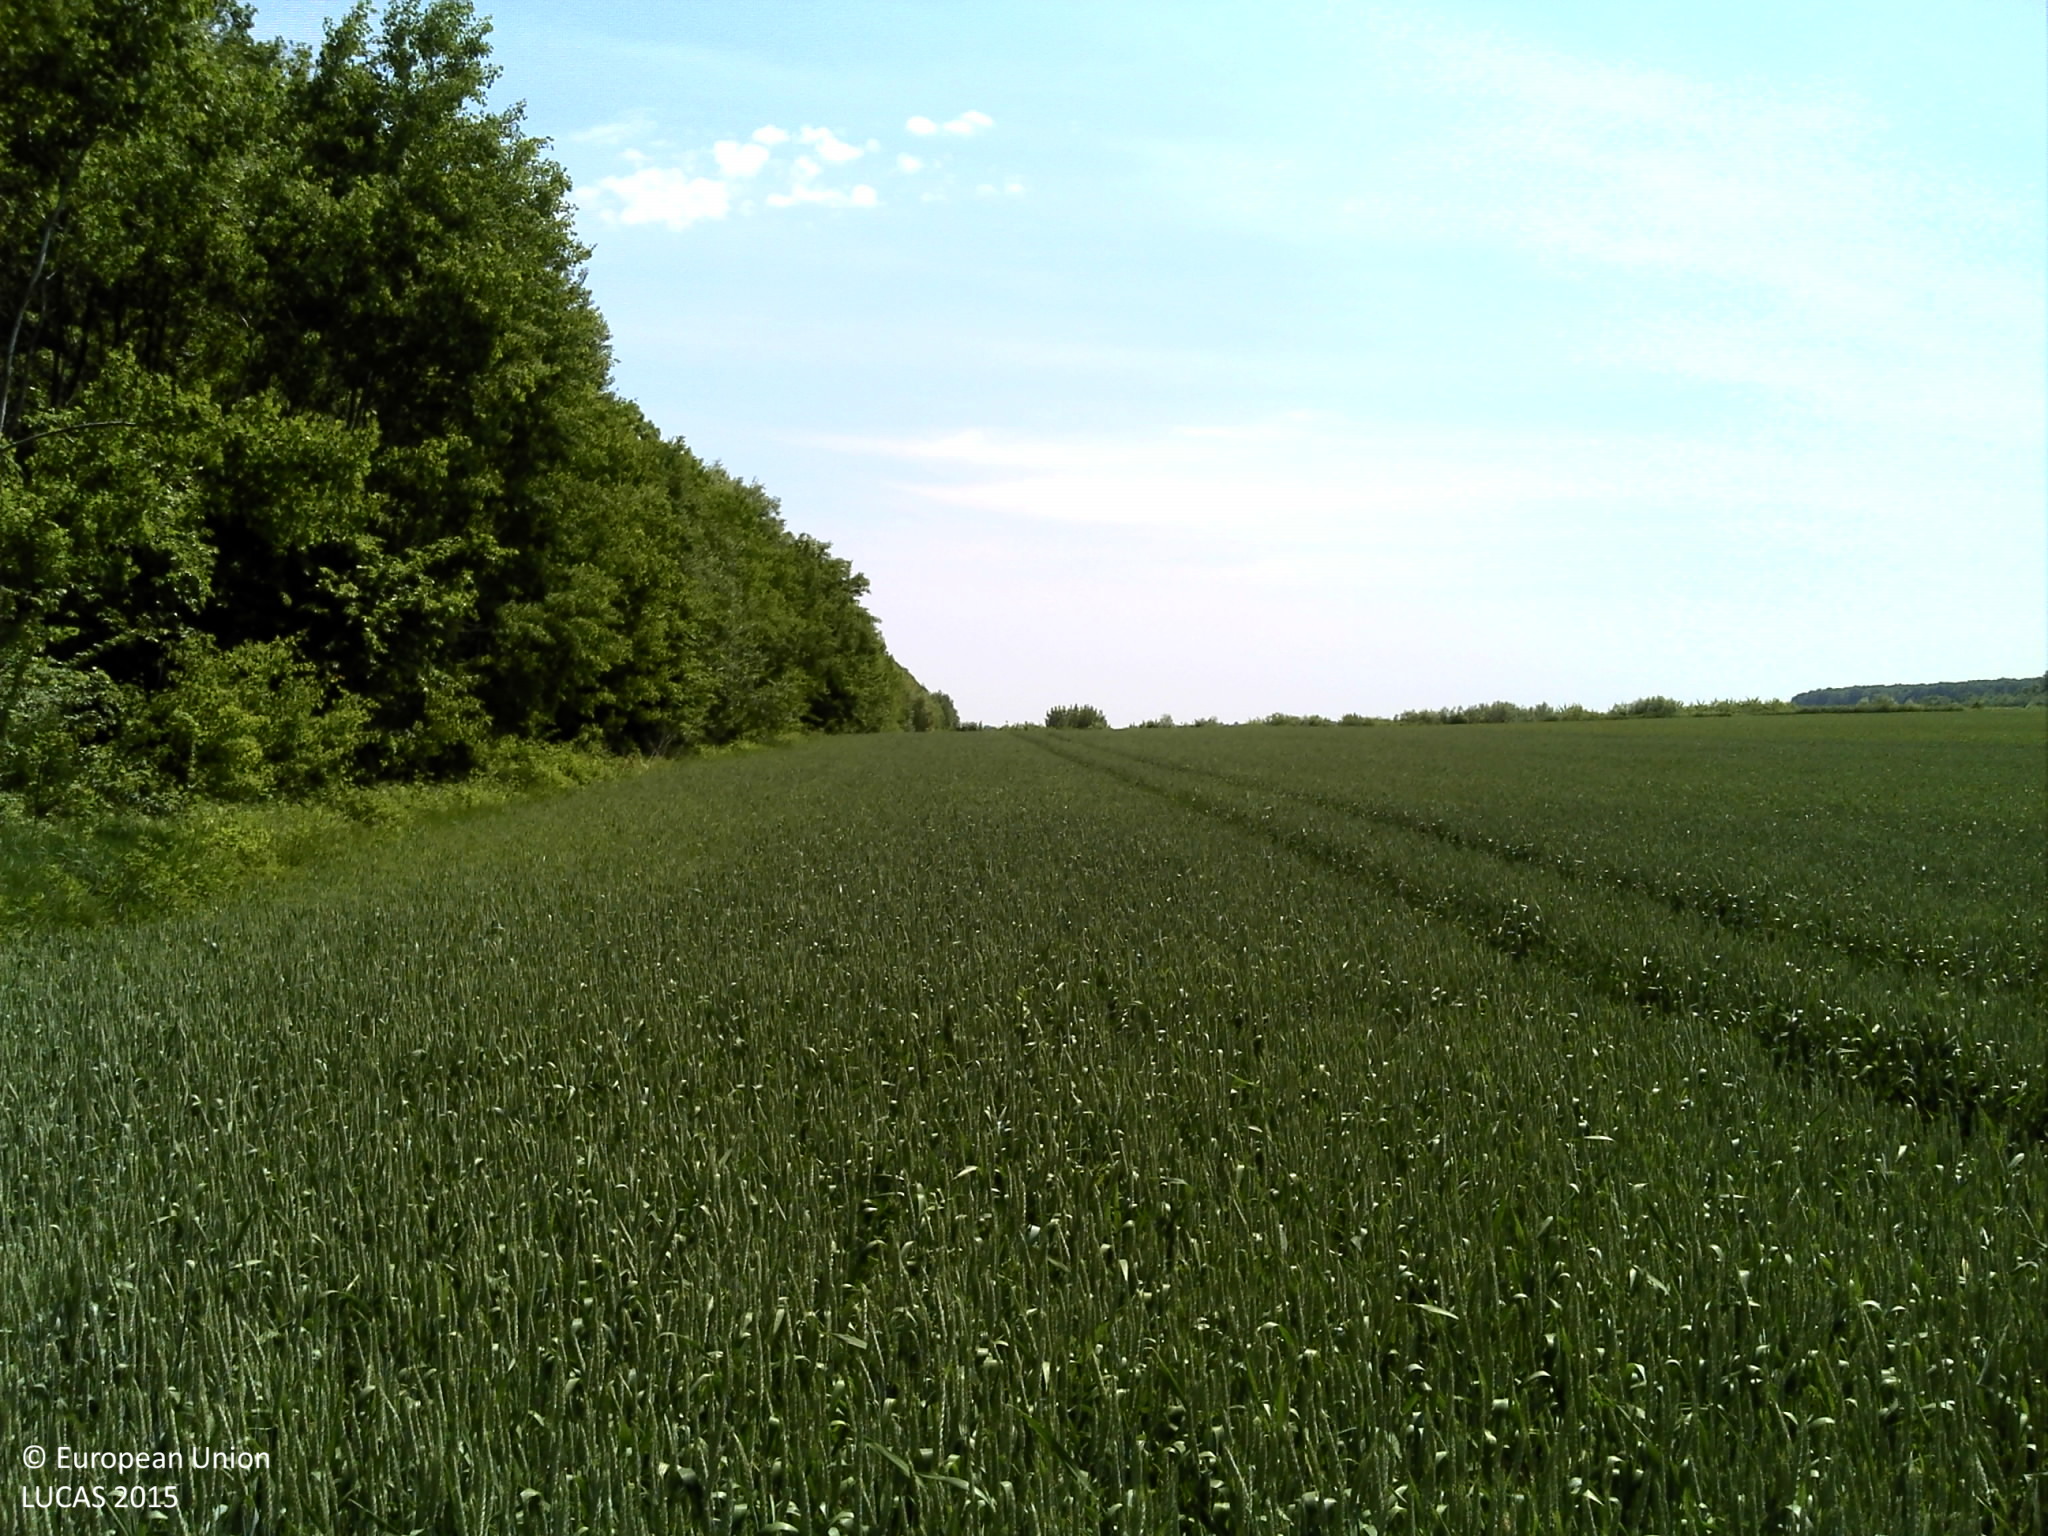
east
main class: Cropland
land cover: Common wheat
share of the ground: > 75 %
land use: Agriculture (excluding fallow land and kitchen gardens)
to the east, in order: Common wheat; Ditches and canals; Shrubland with sparse tree cover; Broadleaved woodland
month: May
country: HR
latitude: 45.5102
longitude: 18.2096
